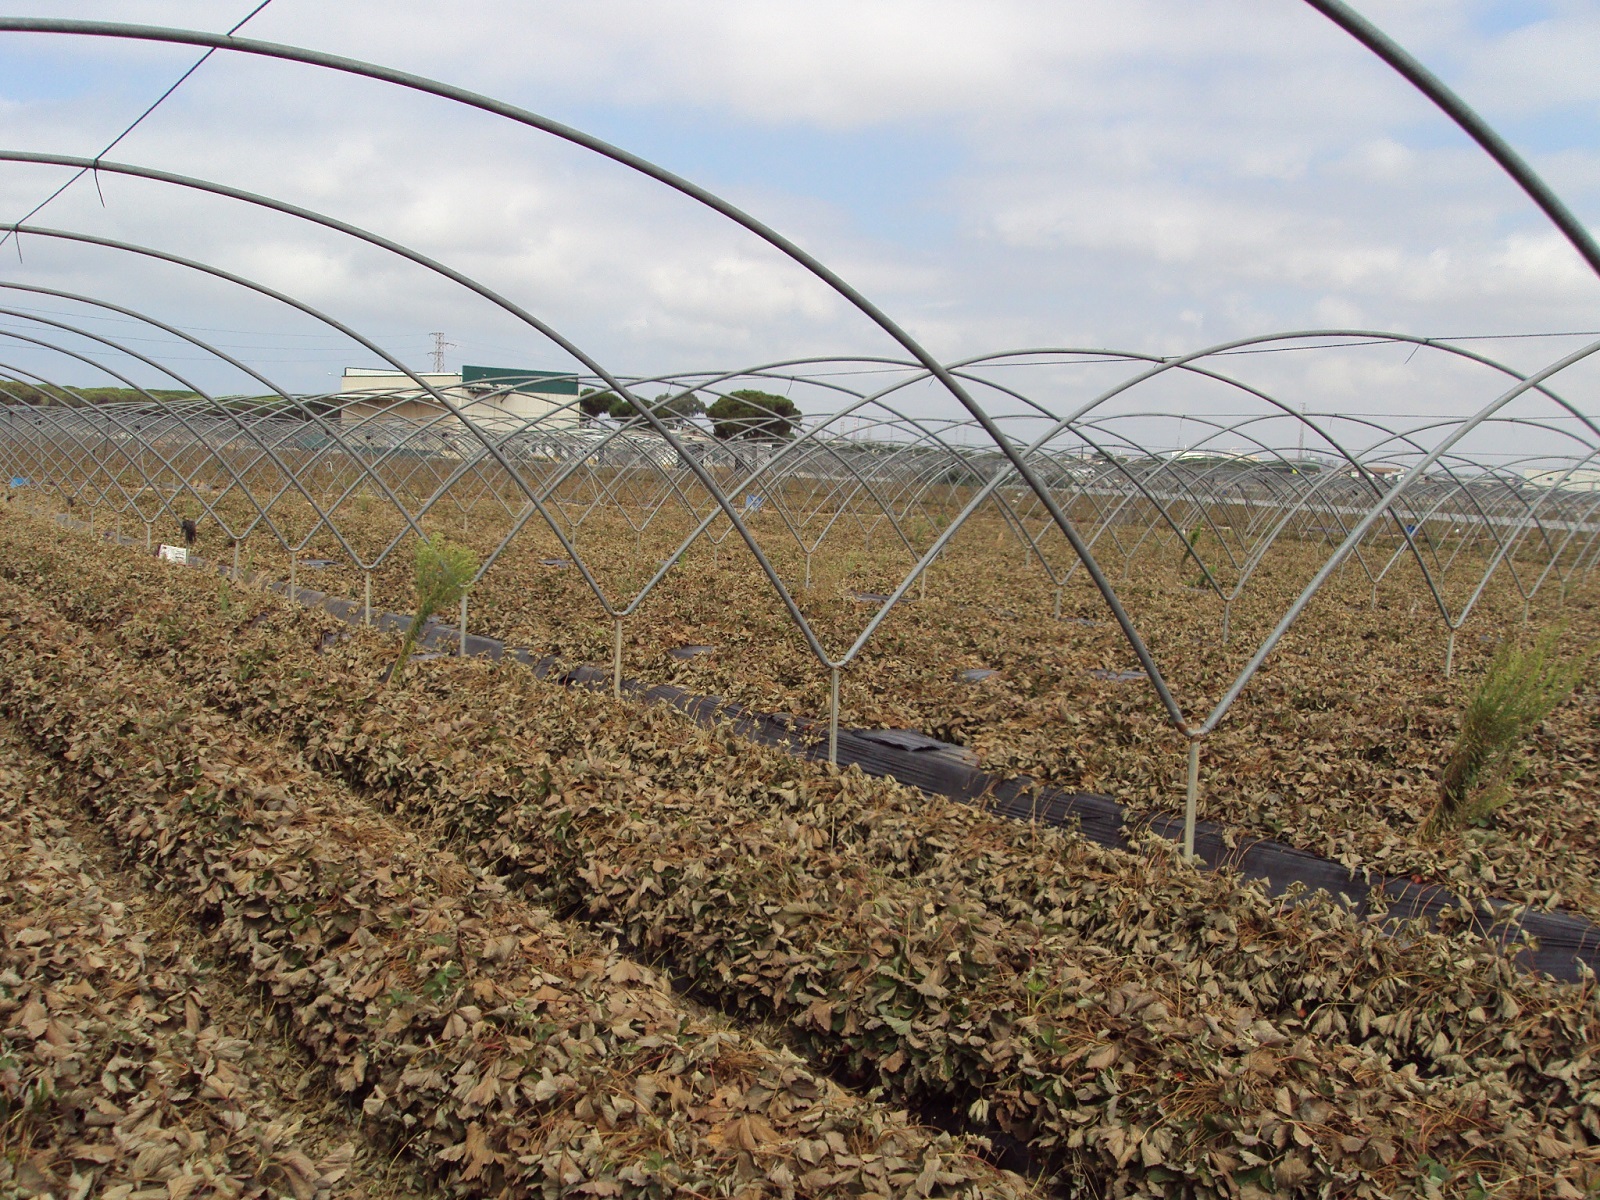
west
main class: Artificial land
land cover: Greenhouses
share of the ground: > 75 %
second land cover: Strawberries
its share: > 75 %
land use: Agriculture (excluding fallow land and kitchen gardens)
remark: Harvested field
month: June
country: ES
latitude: 37.1743
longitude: -6.8499
